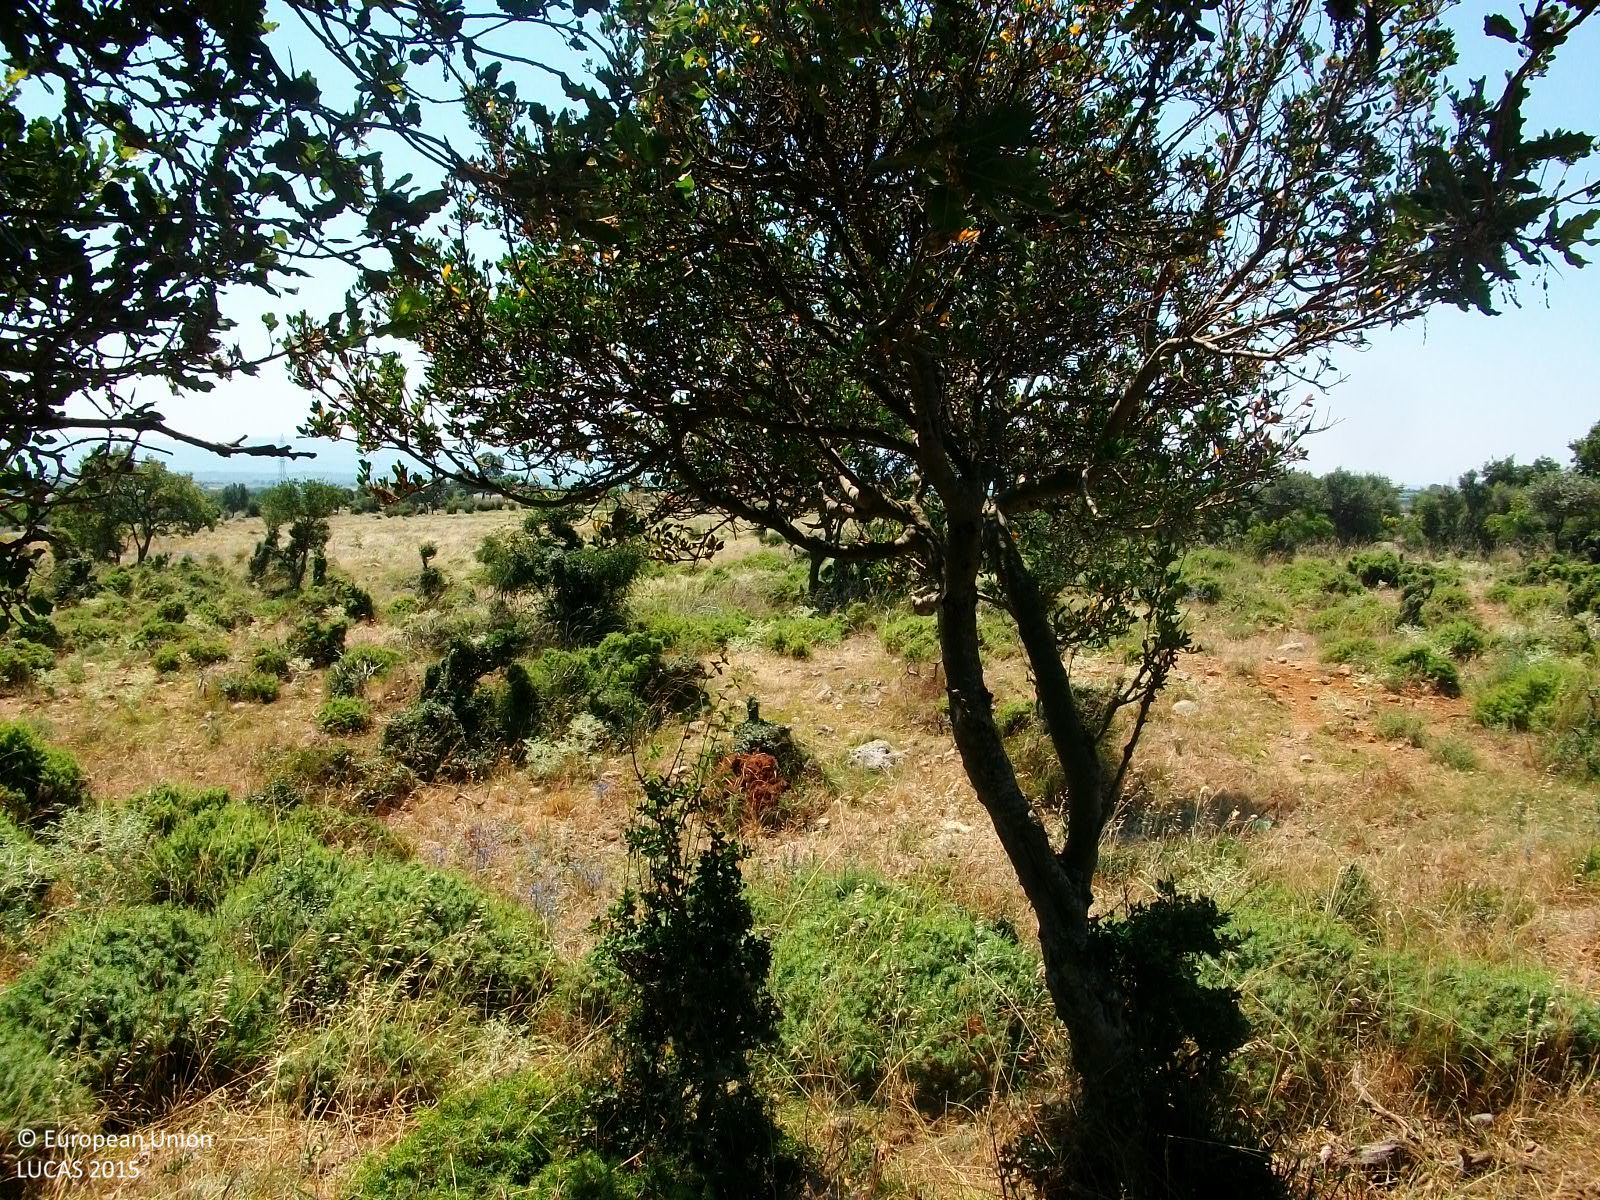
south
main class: Woodland
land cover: Broadleaved woodland
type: thermophilous deciduous forest
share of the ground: 50 - 75 %
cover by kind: broadleaved forest trees 50 %, herbaceous plants 25 %, shrubs 15 %, unconsolidated bare surface 10 %
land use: Semi-natural and natural areas not in use
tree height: > 5 m
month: July
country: GR
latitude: 40.8892
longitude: 26.1442
